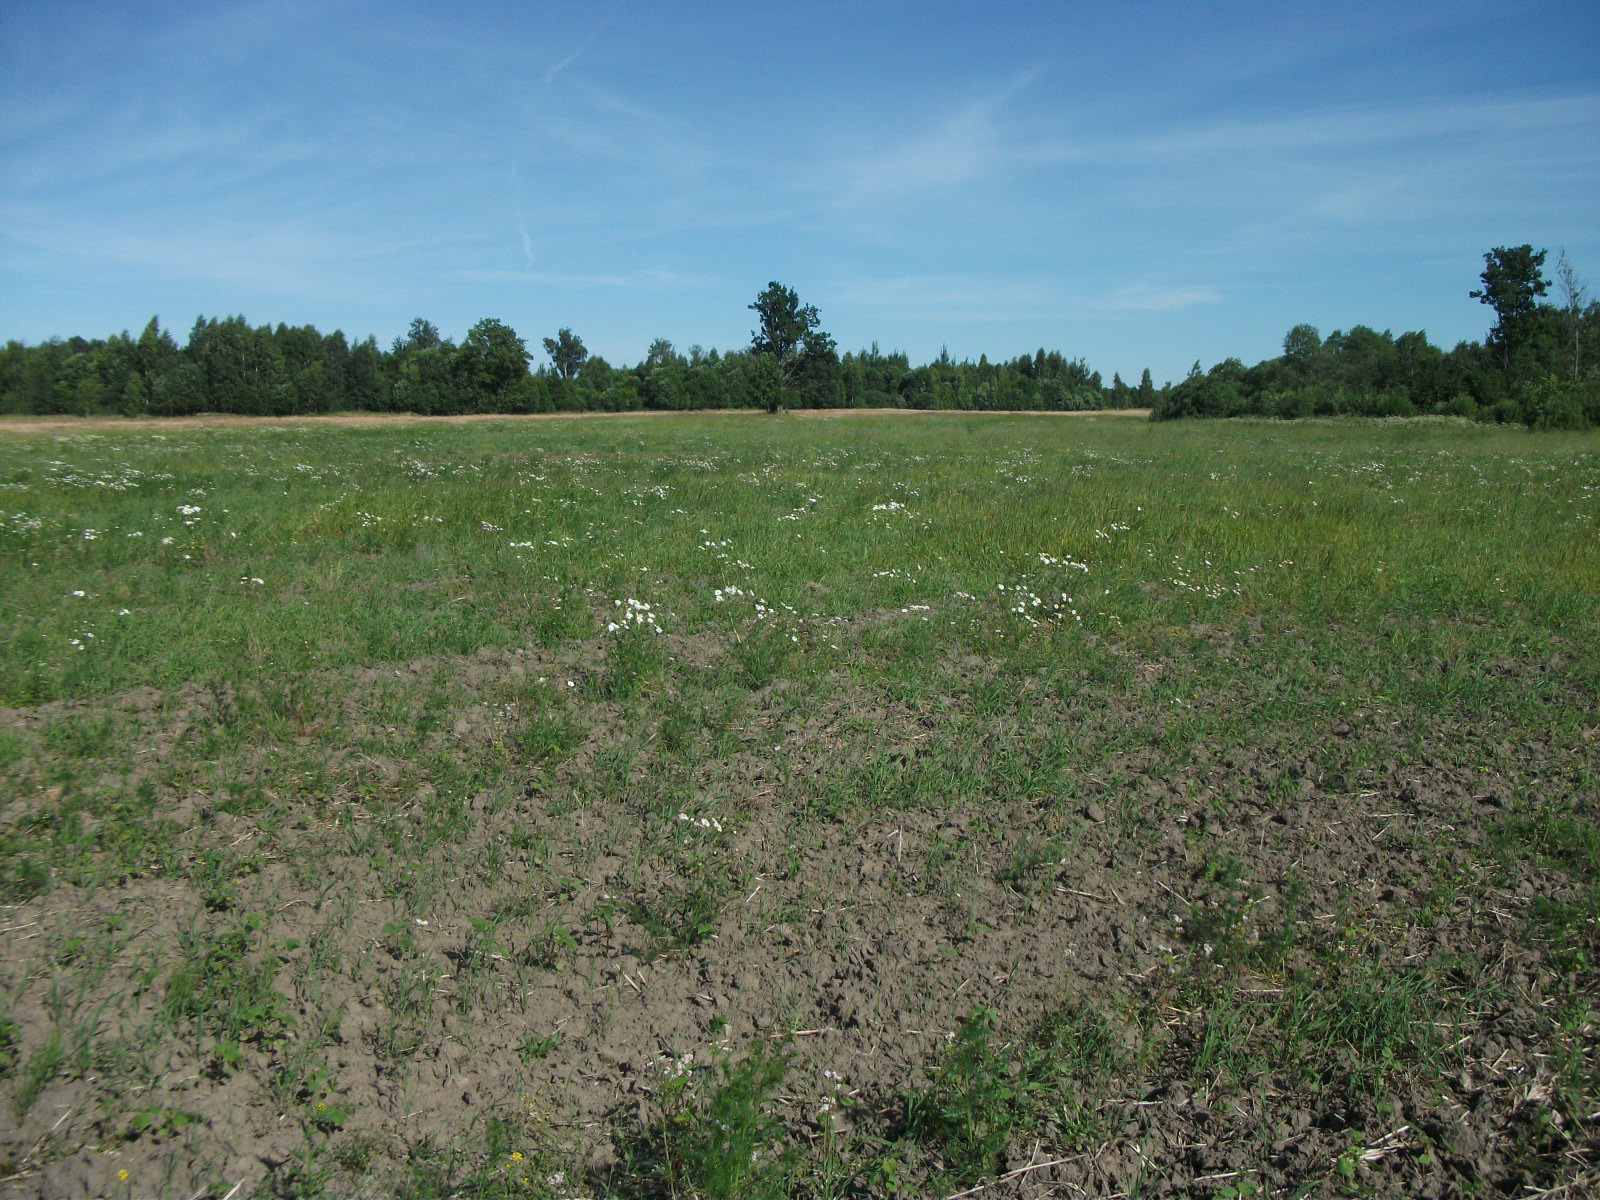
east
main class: Grassland
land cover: Spontaneously vegetated surfaces
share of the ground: > 75 %
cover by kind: herbaceous plants 80 %, unconsolidated bare surface 20 %
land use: Fallow land
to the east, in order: Spontaneously vegetated surfaces
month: July
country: LV
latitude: 56.7436
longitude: 26.3790
